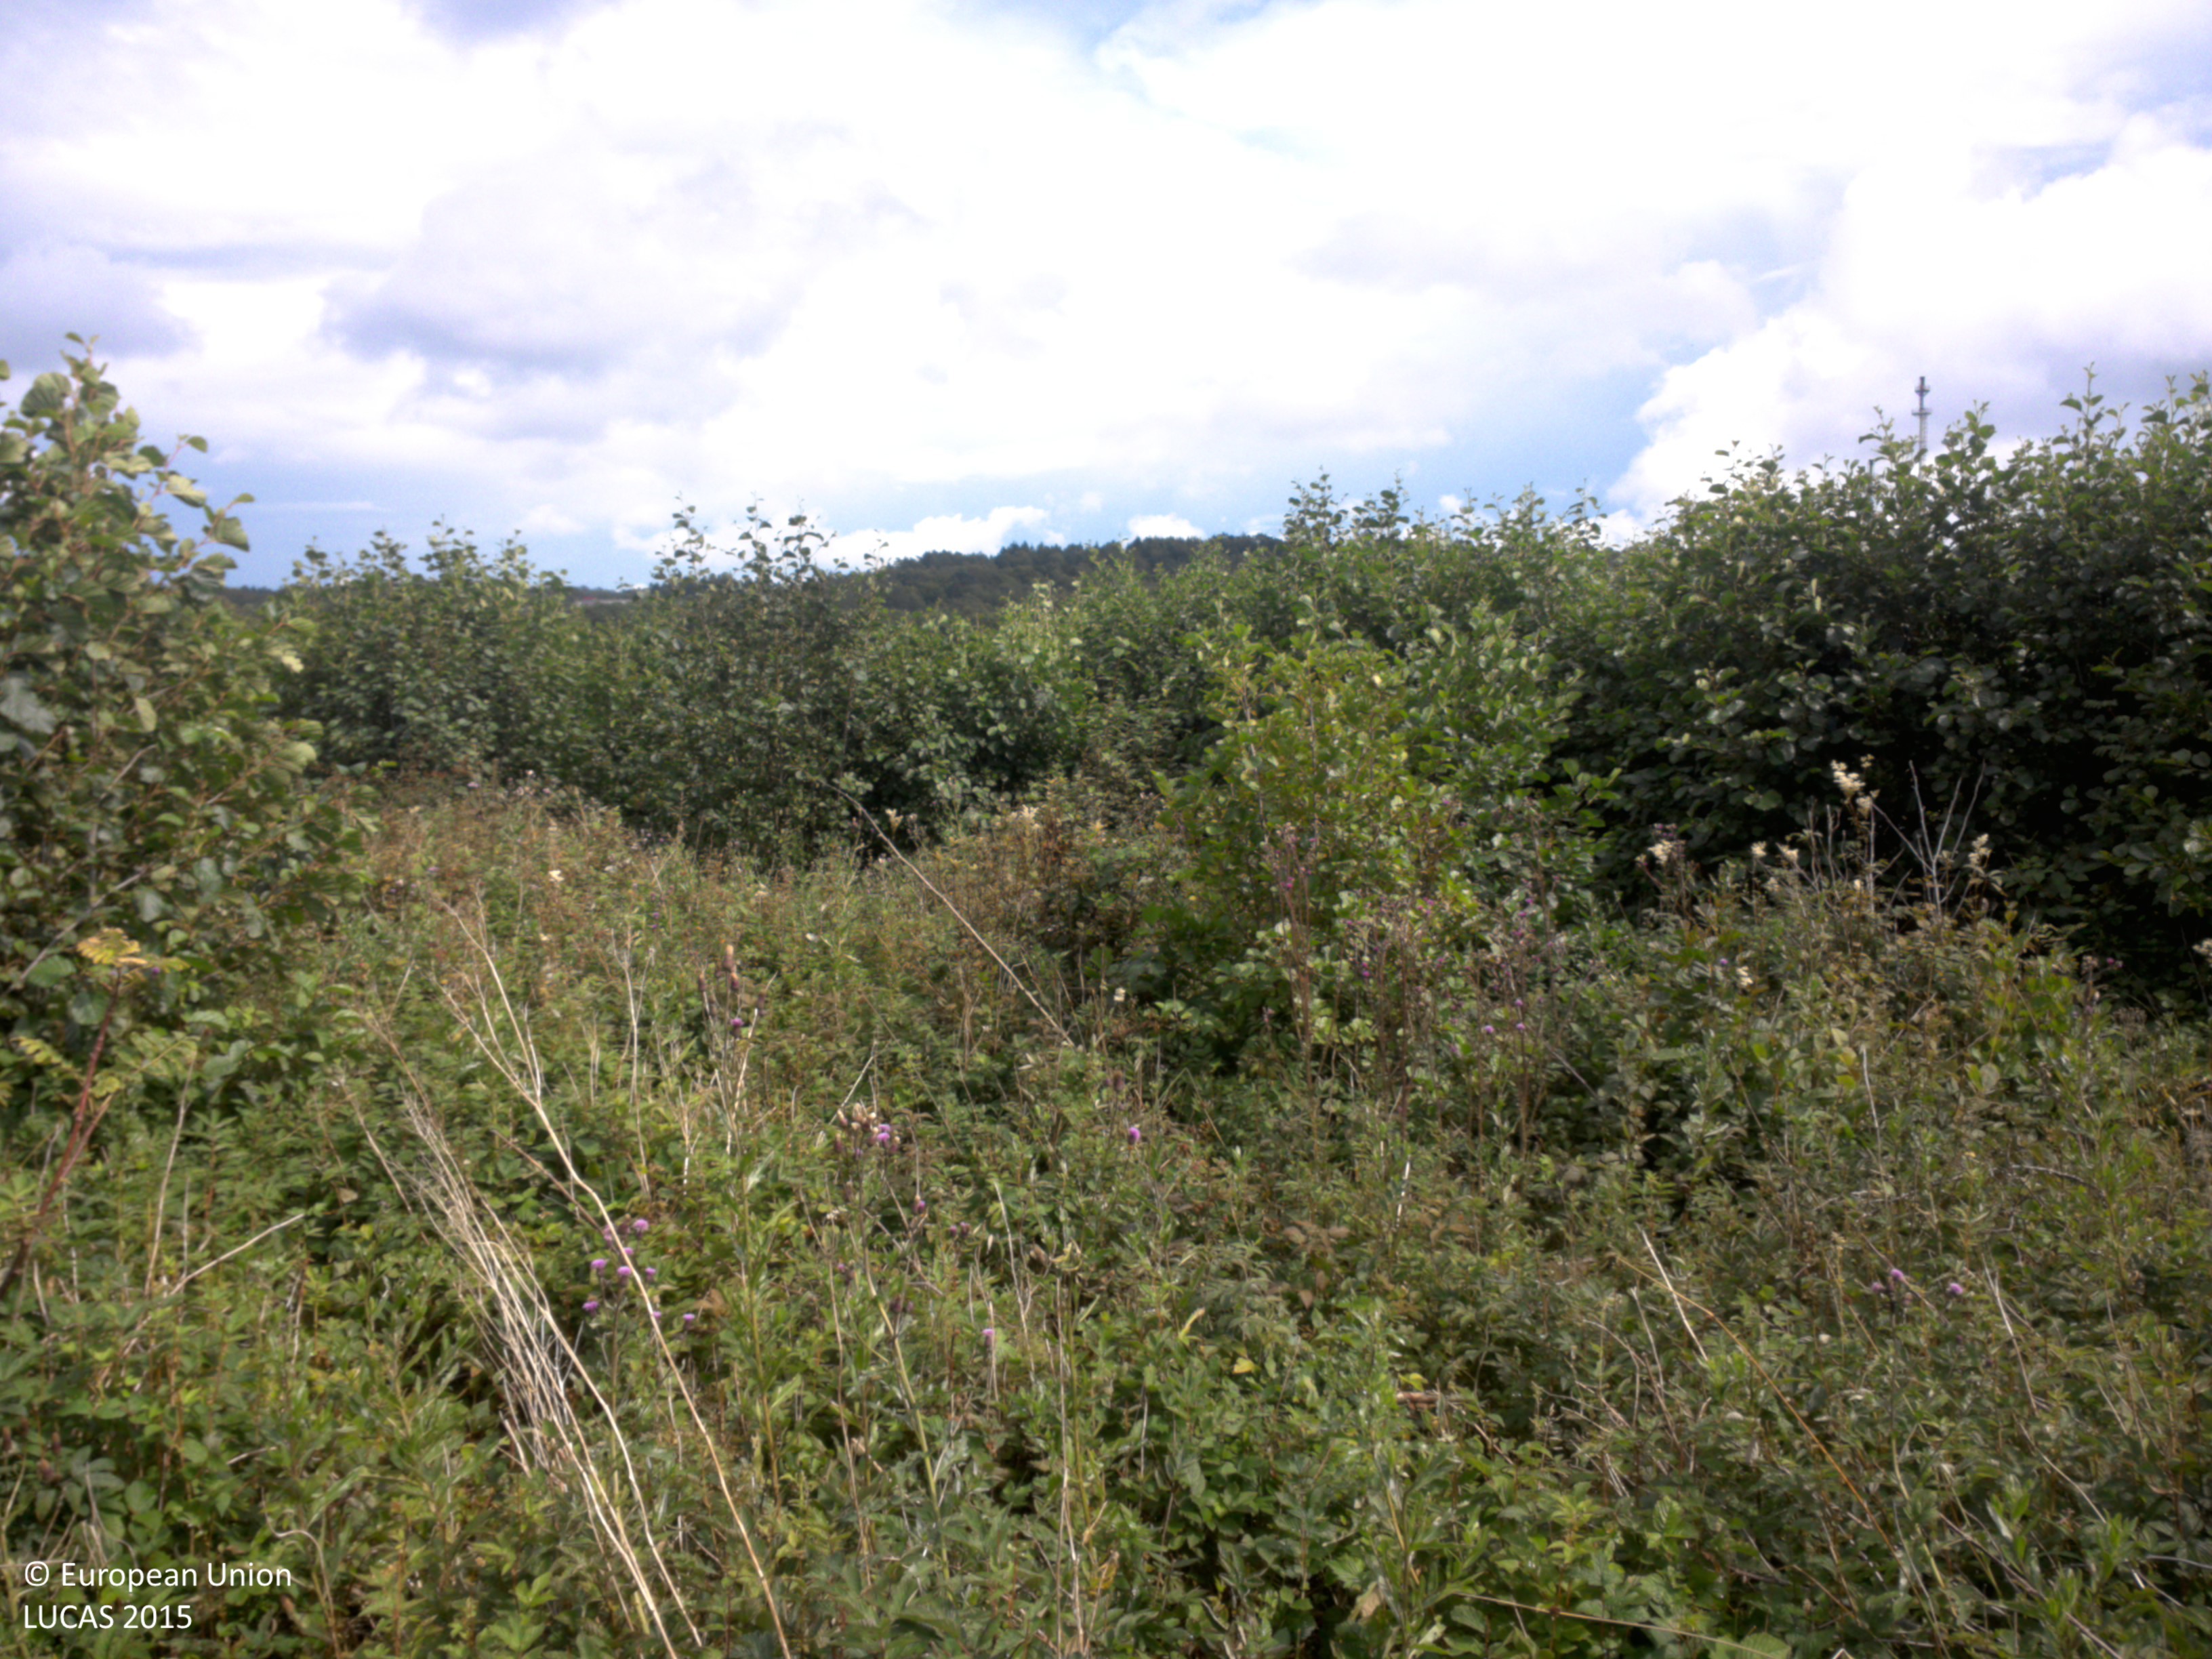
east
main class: Woodland
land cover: Broadleaved woodland
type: hemiboreal forest and nemoral coniferous forest and mixed broadleaved-coniferous forest
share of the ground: 25 - 50 %
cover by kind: broadleaved forest trees 45 %, herbaceous plants 30 %, shrubs 25 %
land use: Semi-natural and natural areas not in use
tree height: < 5 m
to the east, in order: Broadleaved woodland; Ditches and canals; Broadleaved woodland; Tracks; Grass margins; Dry stone walls; Grassland without tree/shrub cover; Paved roads, cycling and walking lanes; Grass margins; Ditches and canals; Grass margins; Barley
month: July
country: SE
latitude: 58.0809
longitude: 11.8449
